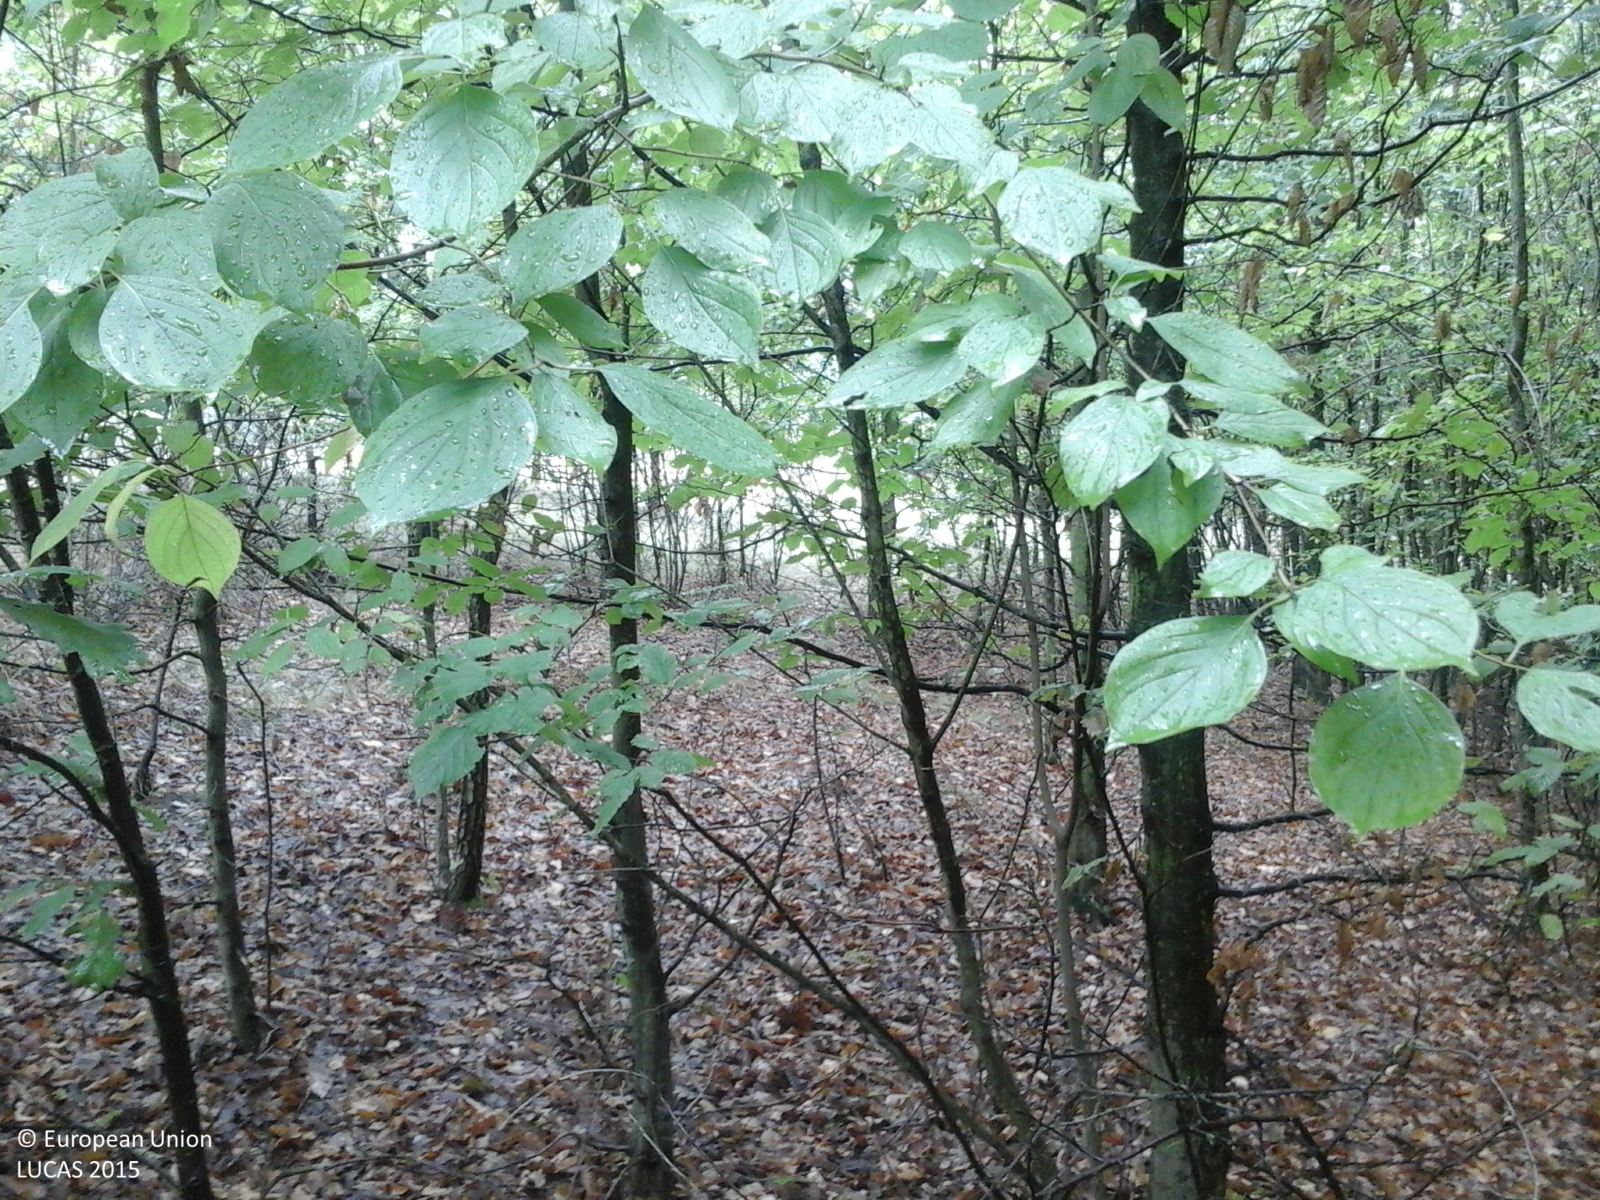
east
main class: Woodland
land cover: Broadleaved woodland
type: acidophilous oak and oak-birch forest
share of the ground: > 75 %
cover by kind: broadleaved forest trees 100 %
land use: Forestry
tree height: > 5 m
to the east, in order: Broadleaved woodland; Grassland with sparse tree/shrub cover; Shrubland with sparse tree cover; Grassland without tree/shrub cover; Tracks; Broadleaved woodland
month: September
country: RO
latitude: 47.3491
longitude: 22.6204
